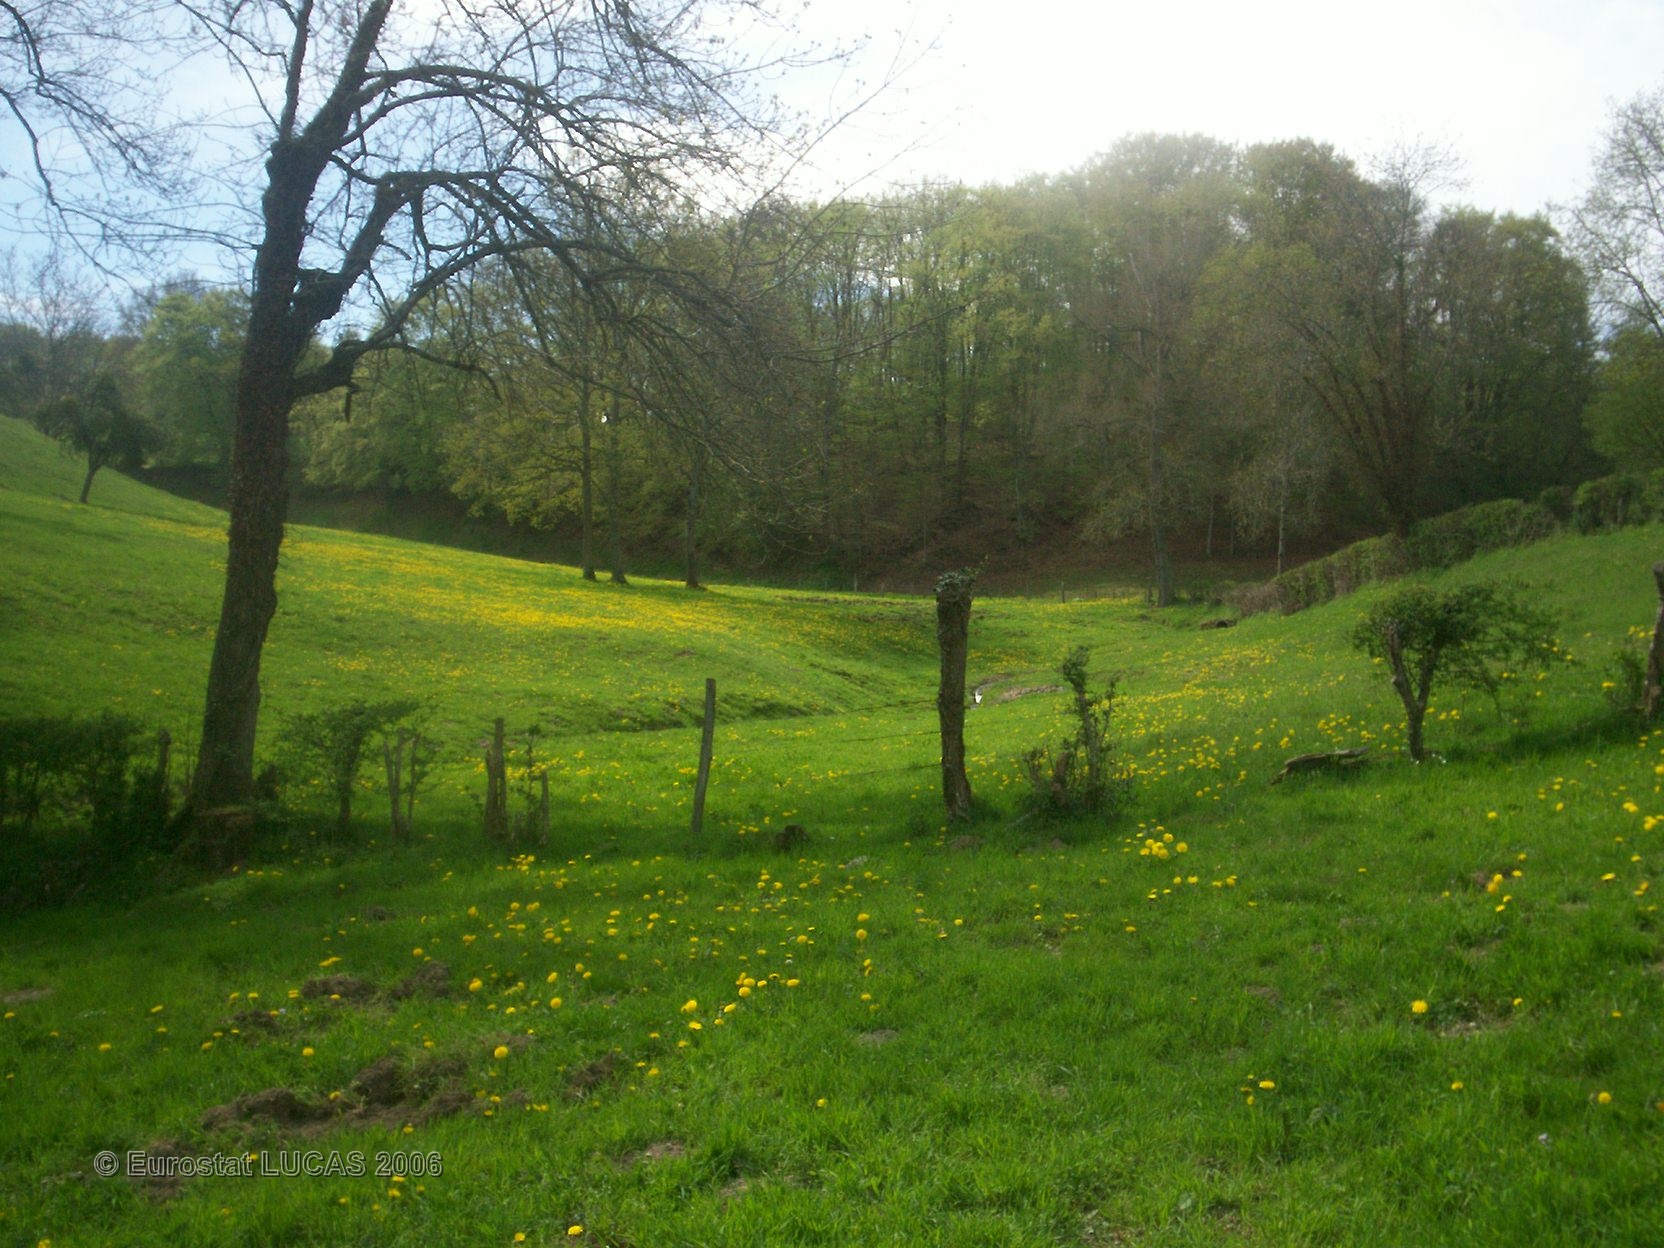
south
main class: Grassland
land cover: Grassland without tree/shrub cover
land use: Agriculture (excluding fallow land and kitchen gardens)
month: May
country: FR
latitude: 46.0072
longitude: 2.9085
